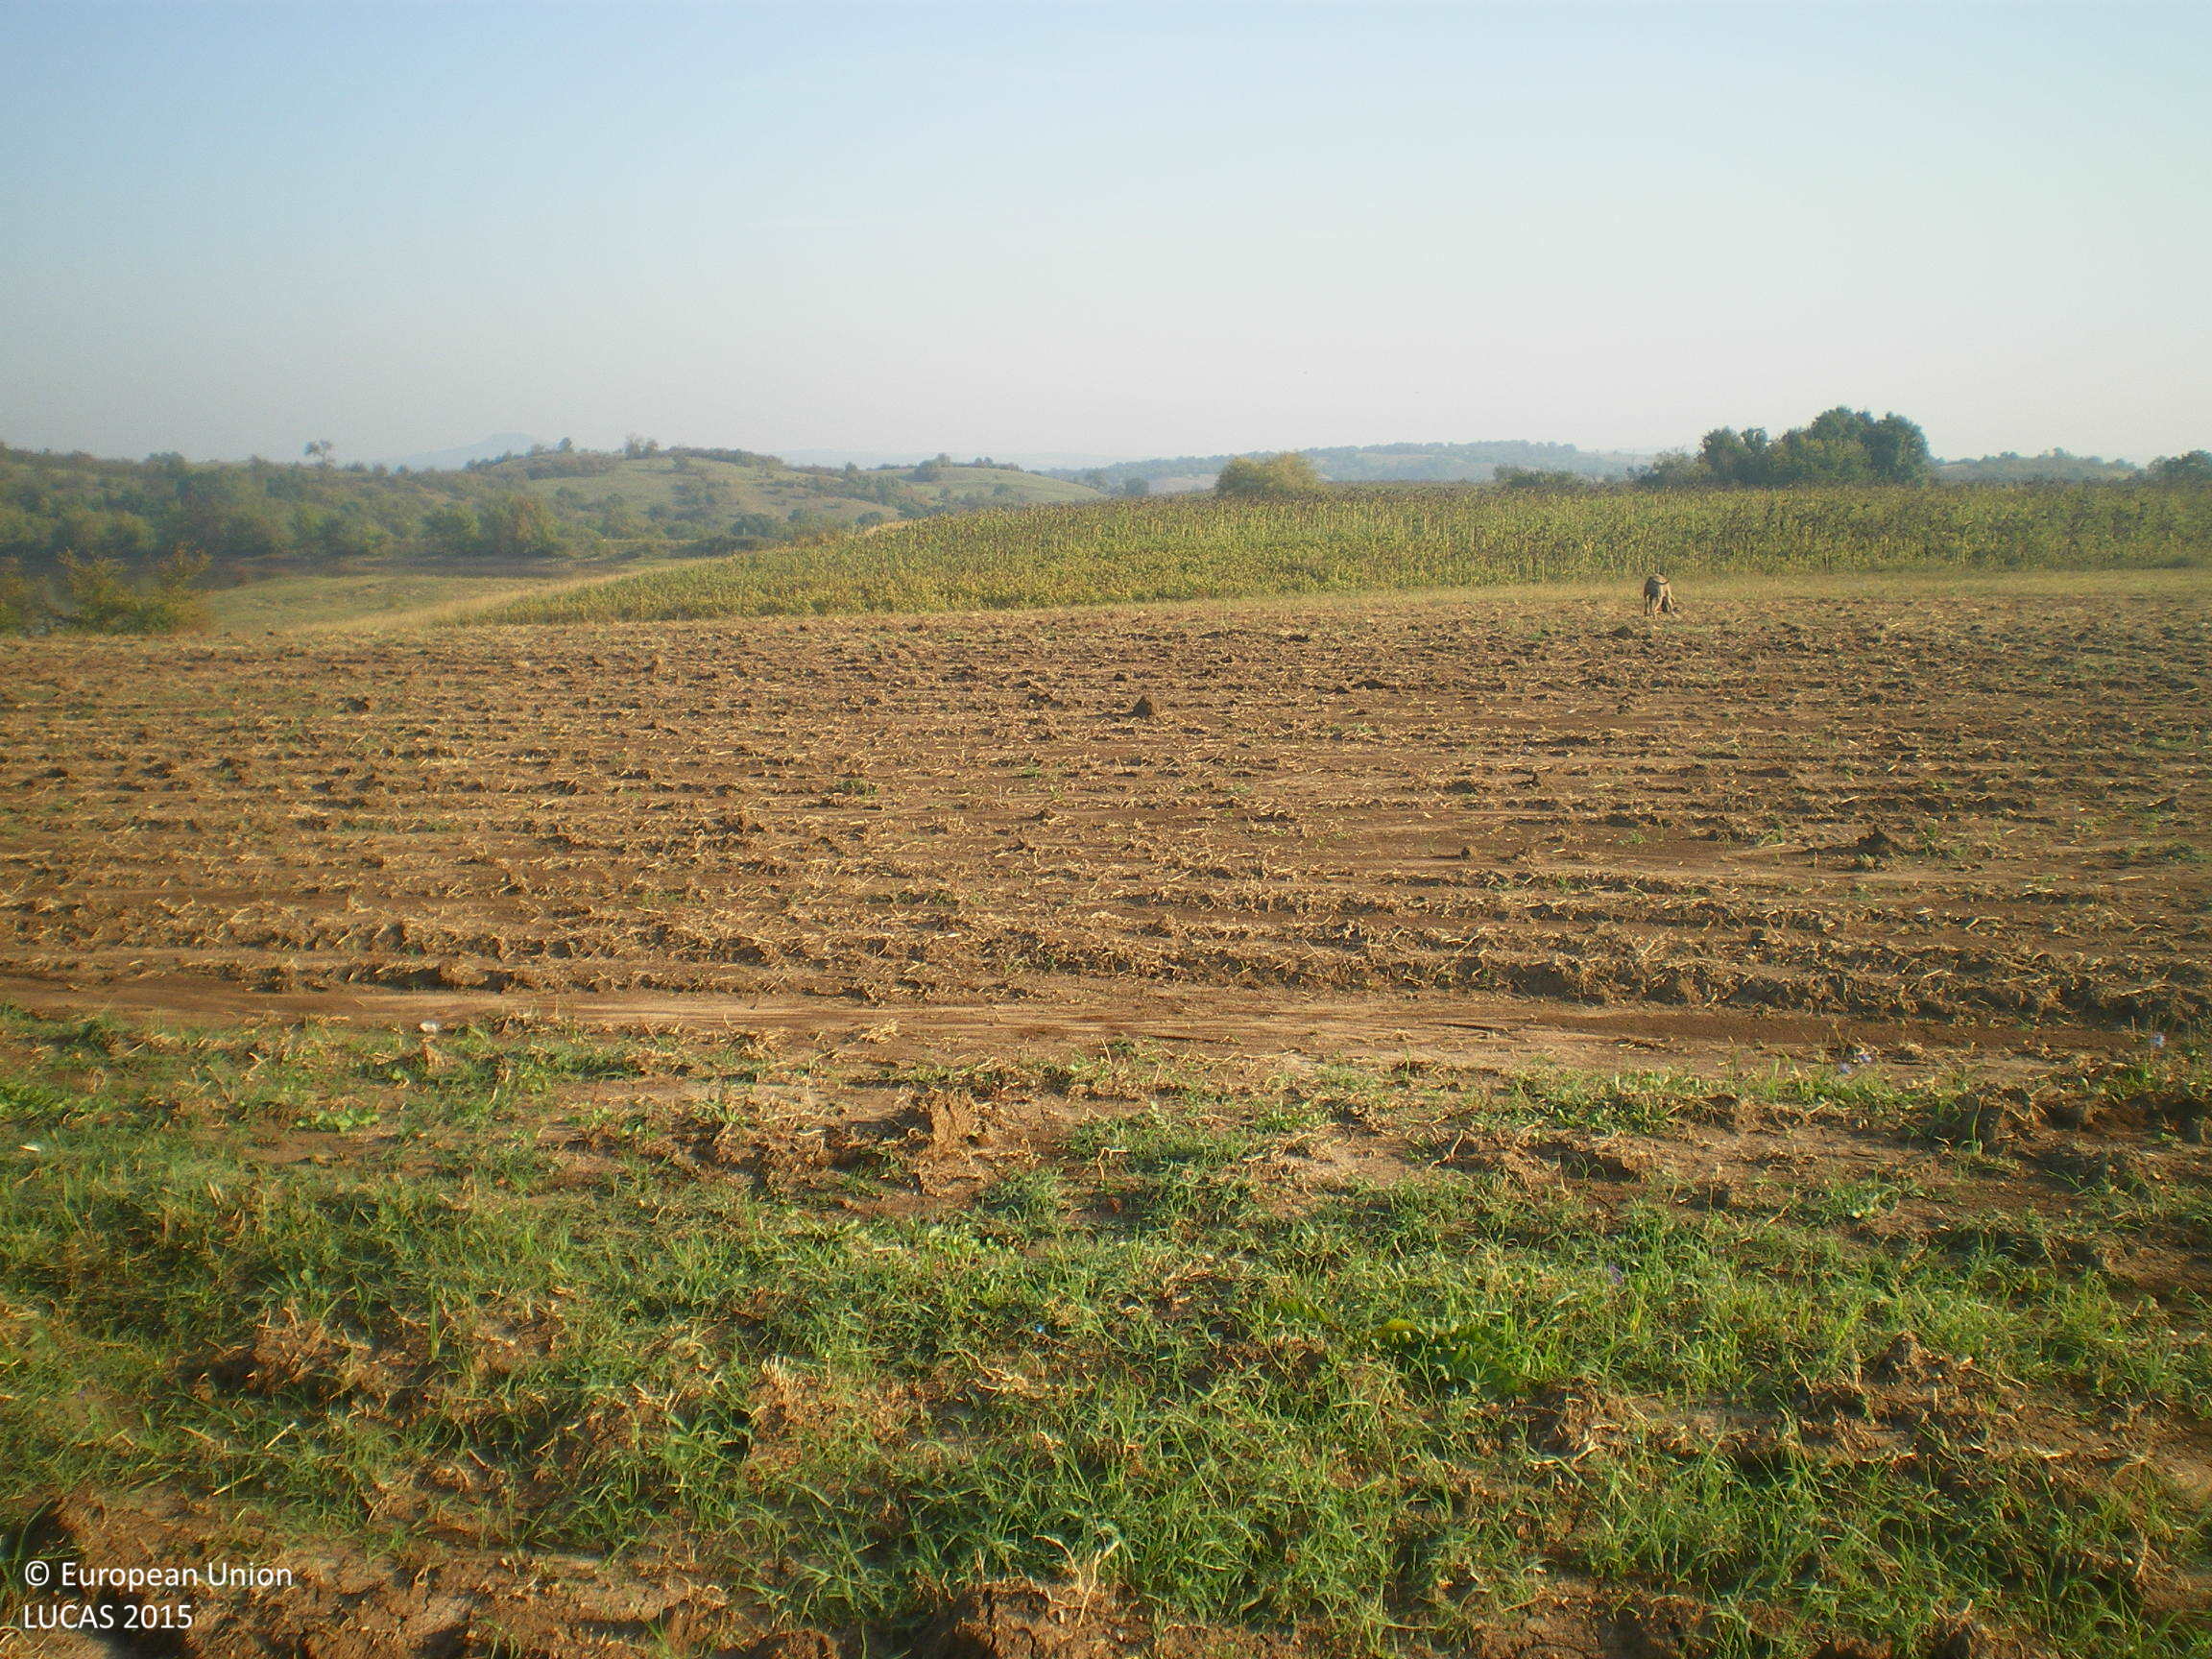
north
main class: Cropland
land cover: Common wheat
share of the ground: < 10 %
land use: Agriculture (excluding fallow land and kitchen gardens)
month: September
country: BG
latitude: 41.8152
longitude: 25.8753
